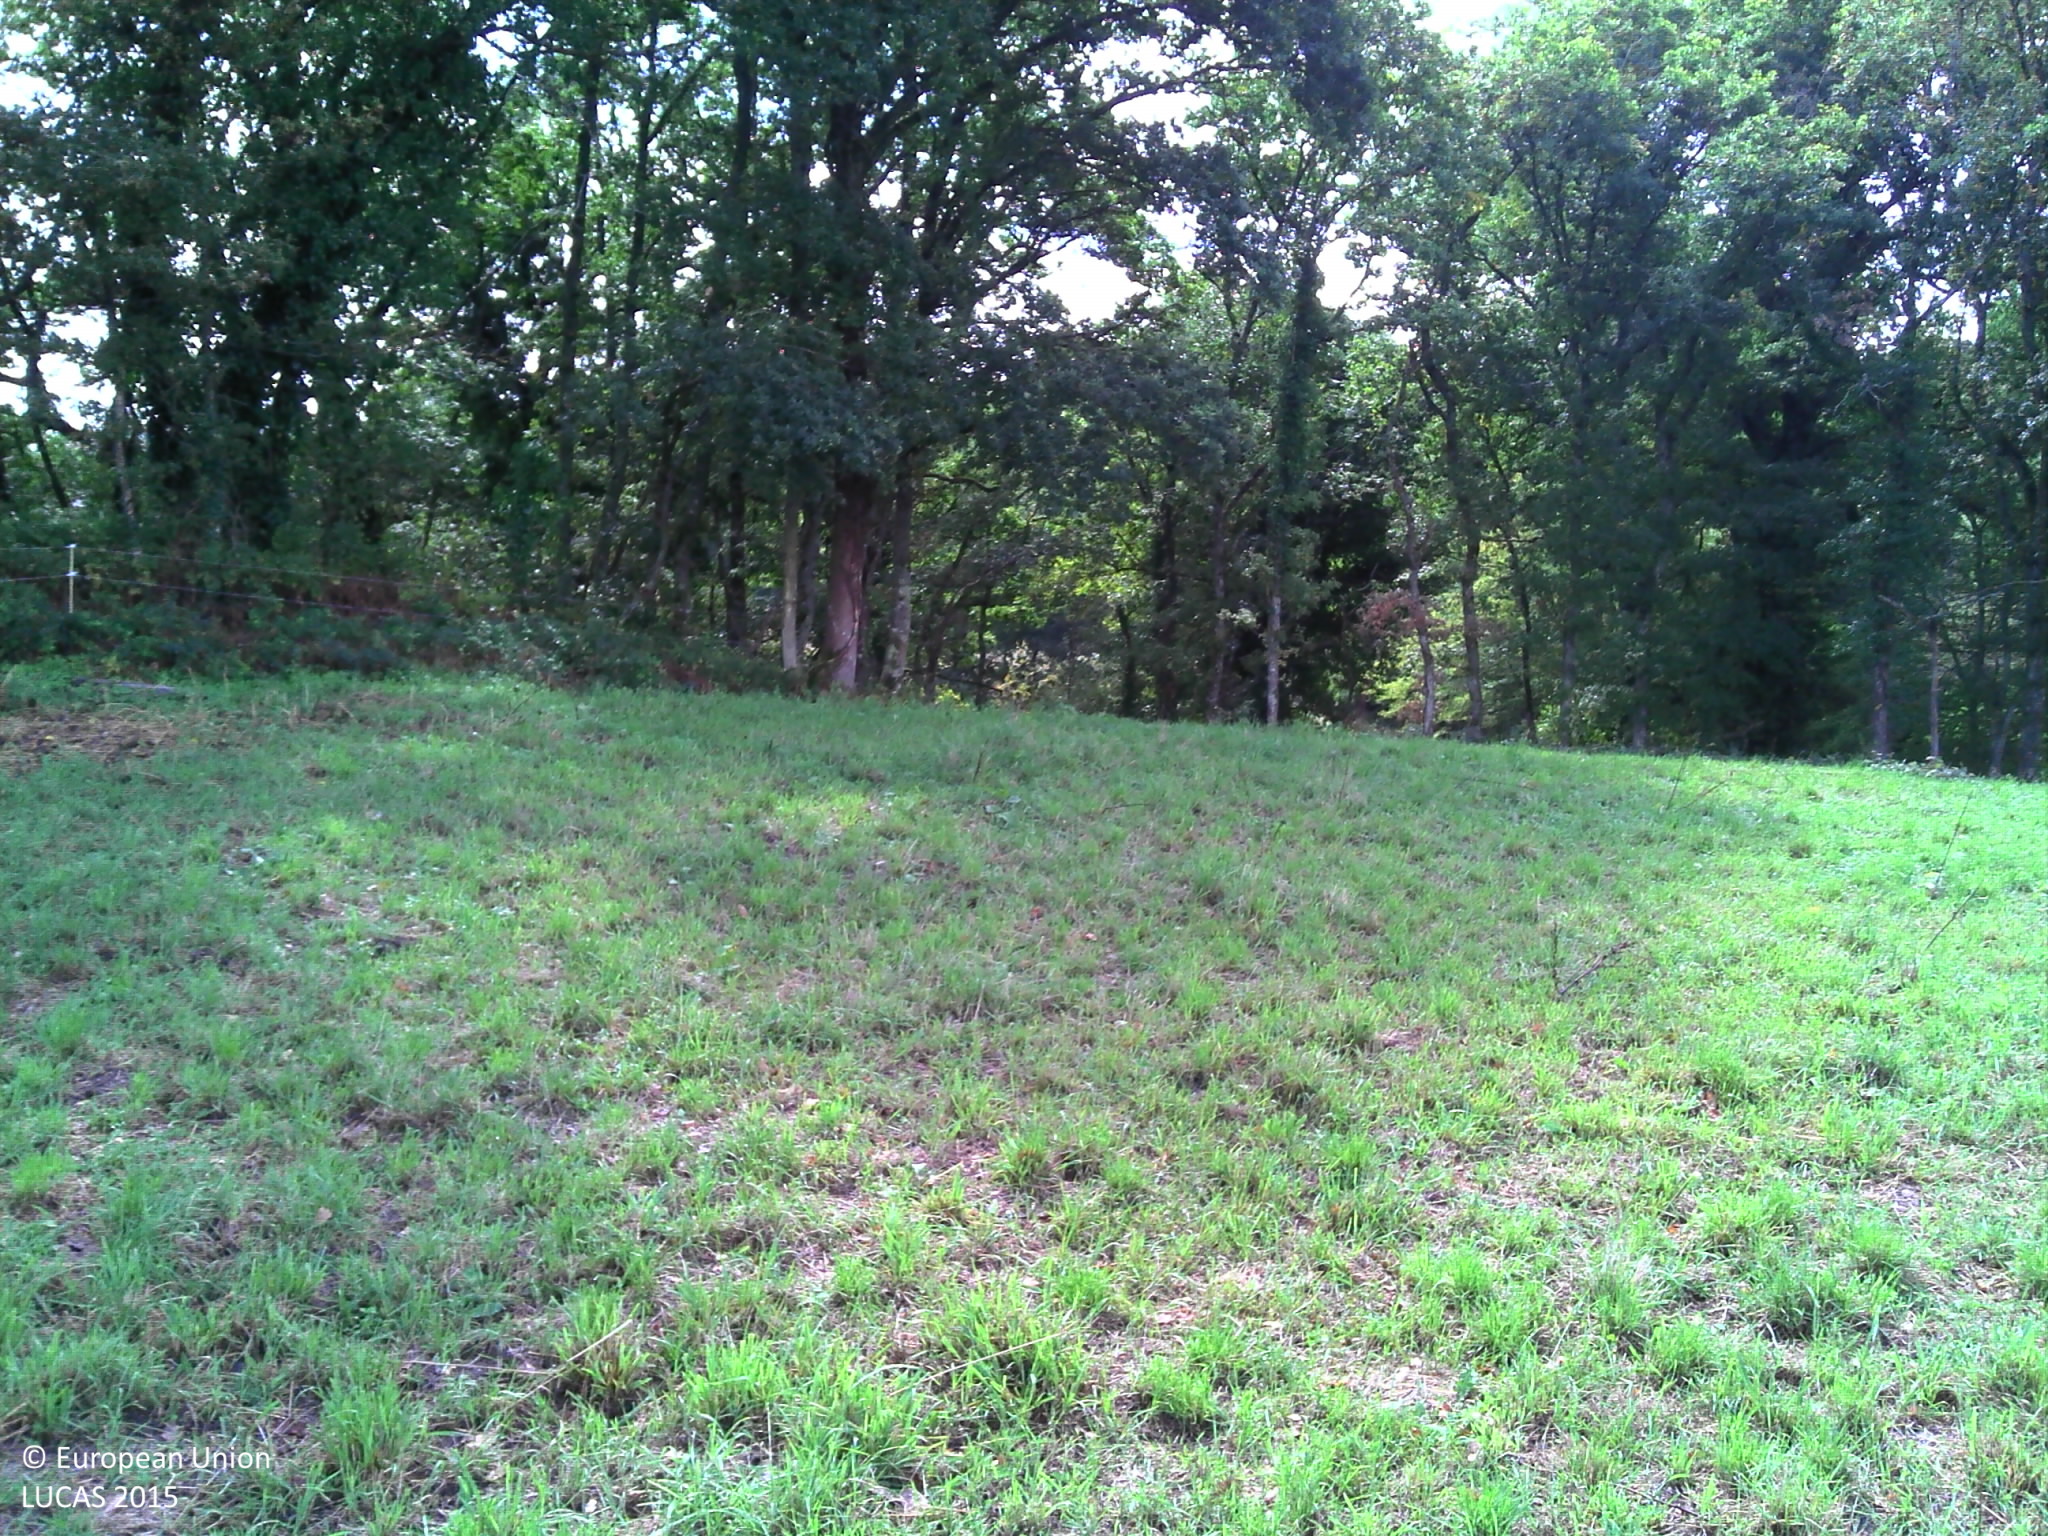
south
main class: Grassland
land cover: Grassland without tree/shrub cover
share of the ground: > 75 %
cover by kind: herbaceous plants 100 %
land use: Agriculture (excluding fallow land and kitchen gardens)
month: September
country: FR
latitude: 46.4445
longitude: 1.6993
